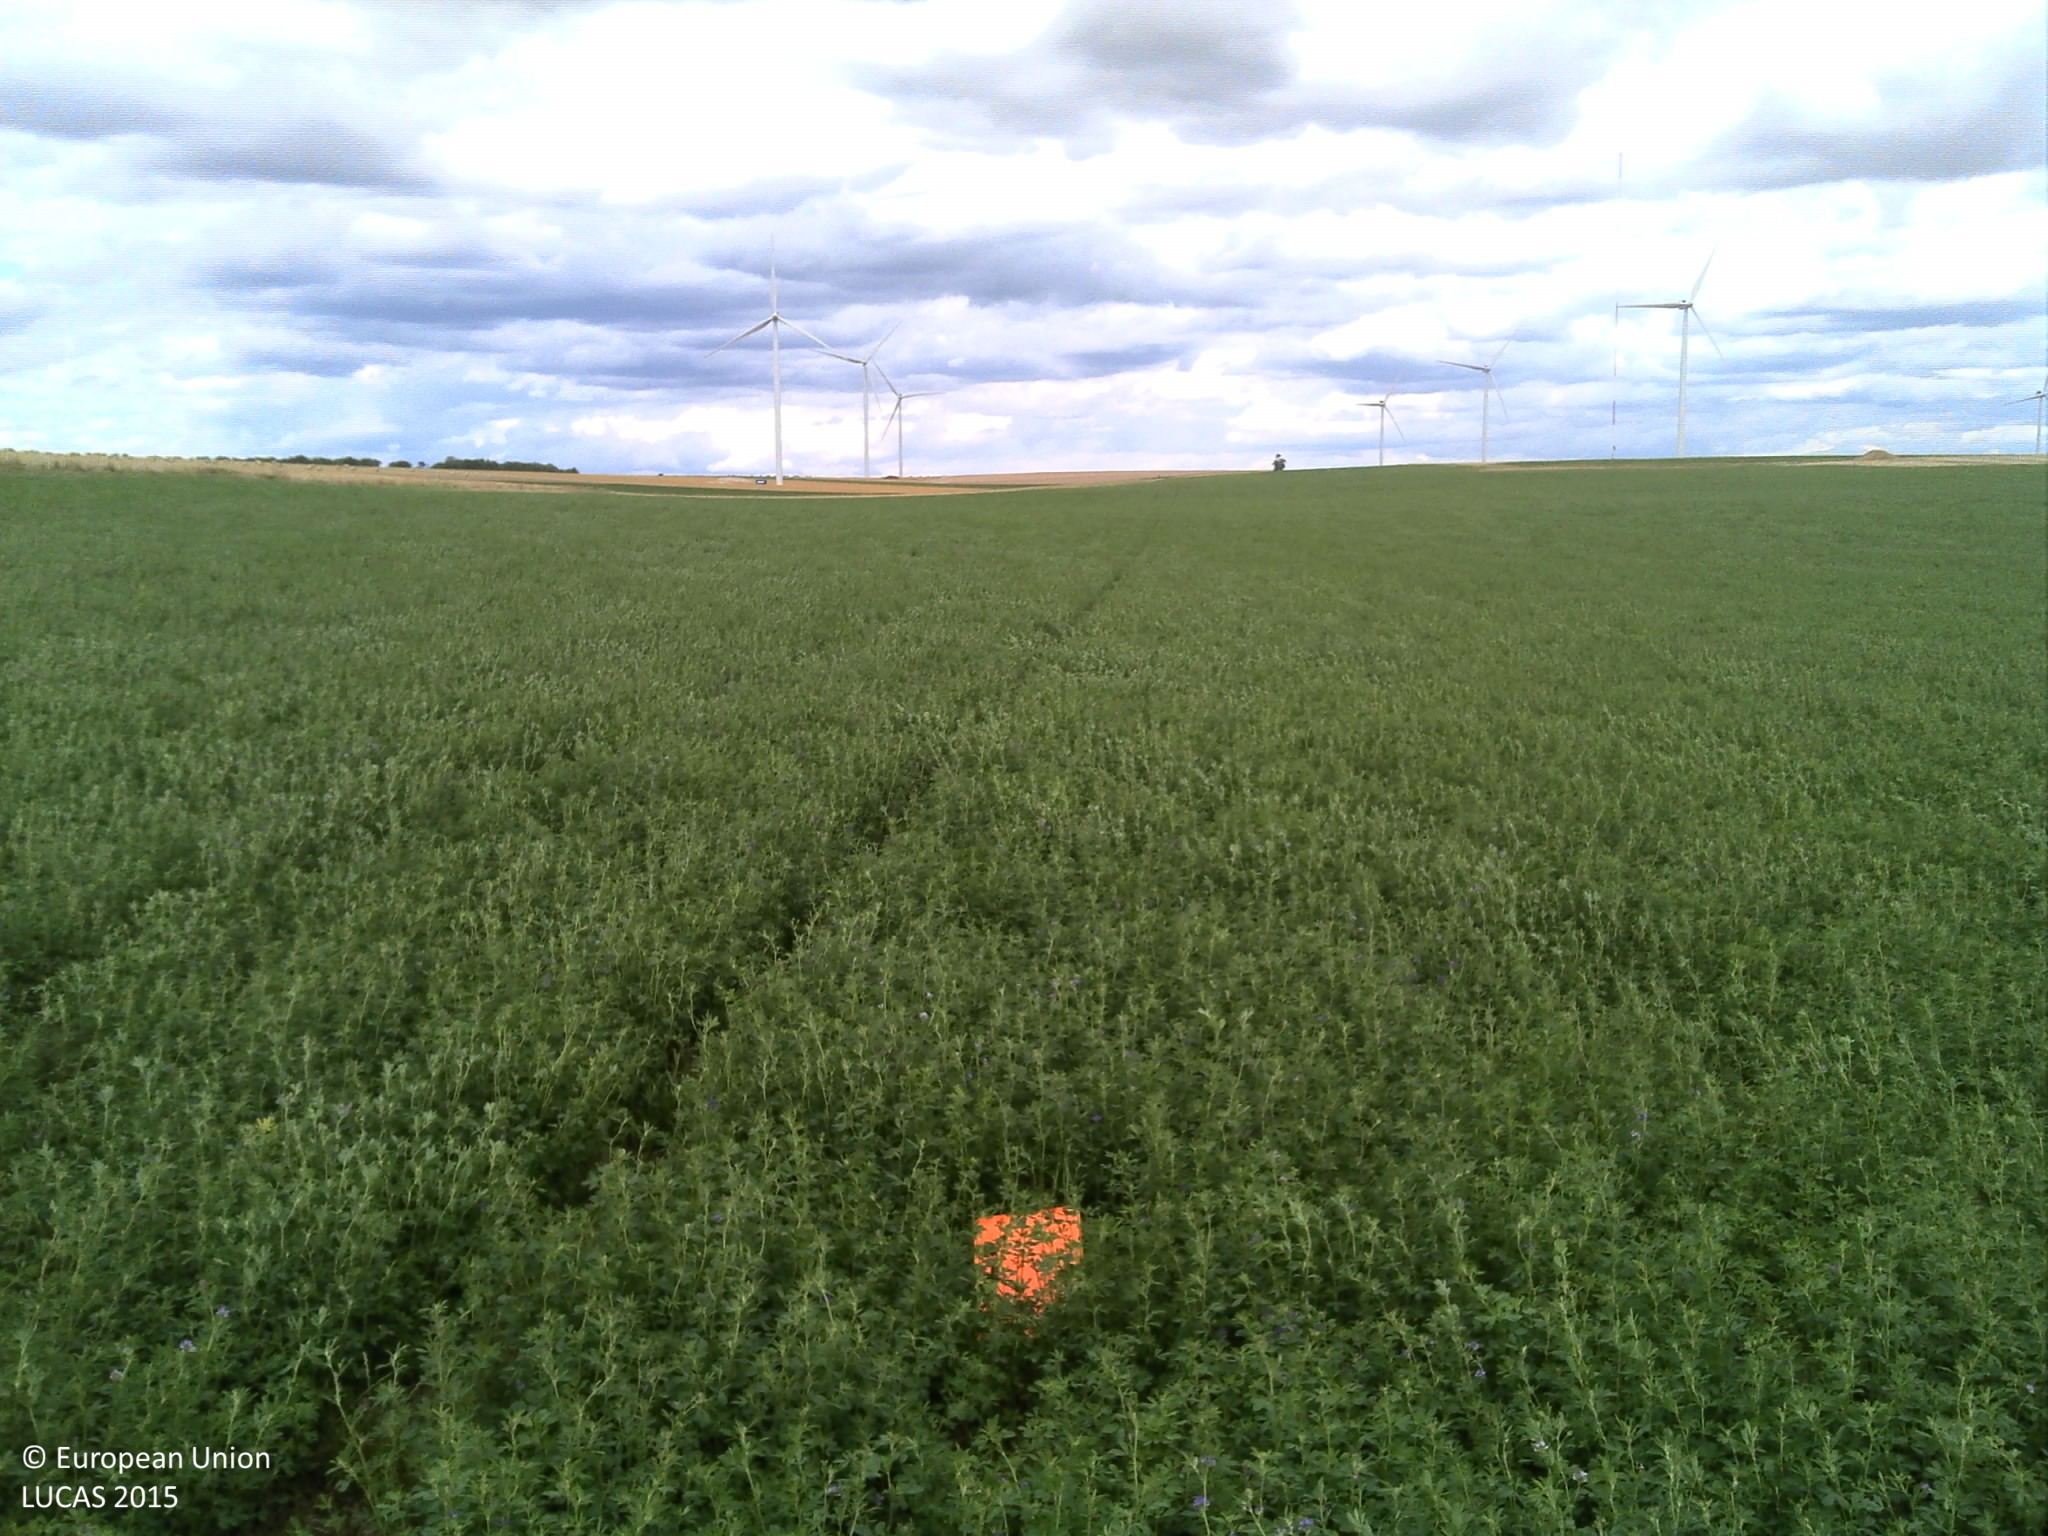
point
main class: Cropland
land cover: Lucerne
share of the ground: > 75 %
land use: Agriculture (excluding fallow land and kitchen gardens)
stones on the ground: < 10 %
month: July
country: FR
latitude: 49.4218
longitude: 4.5234
